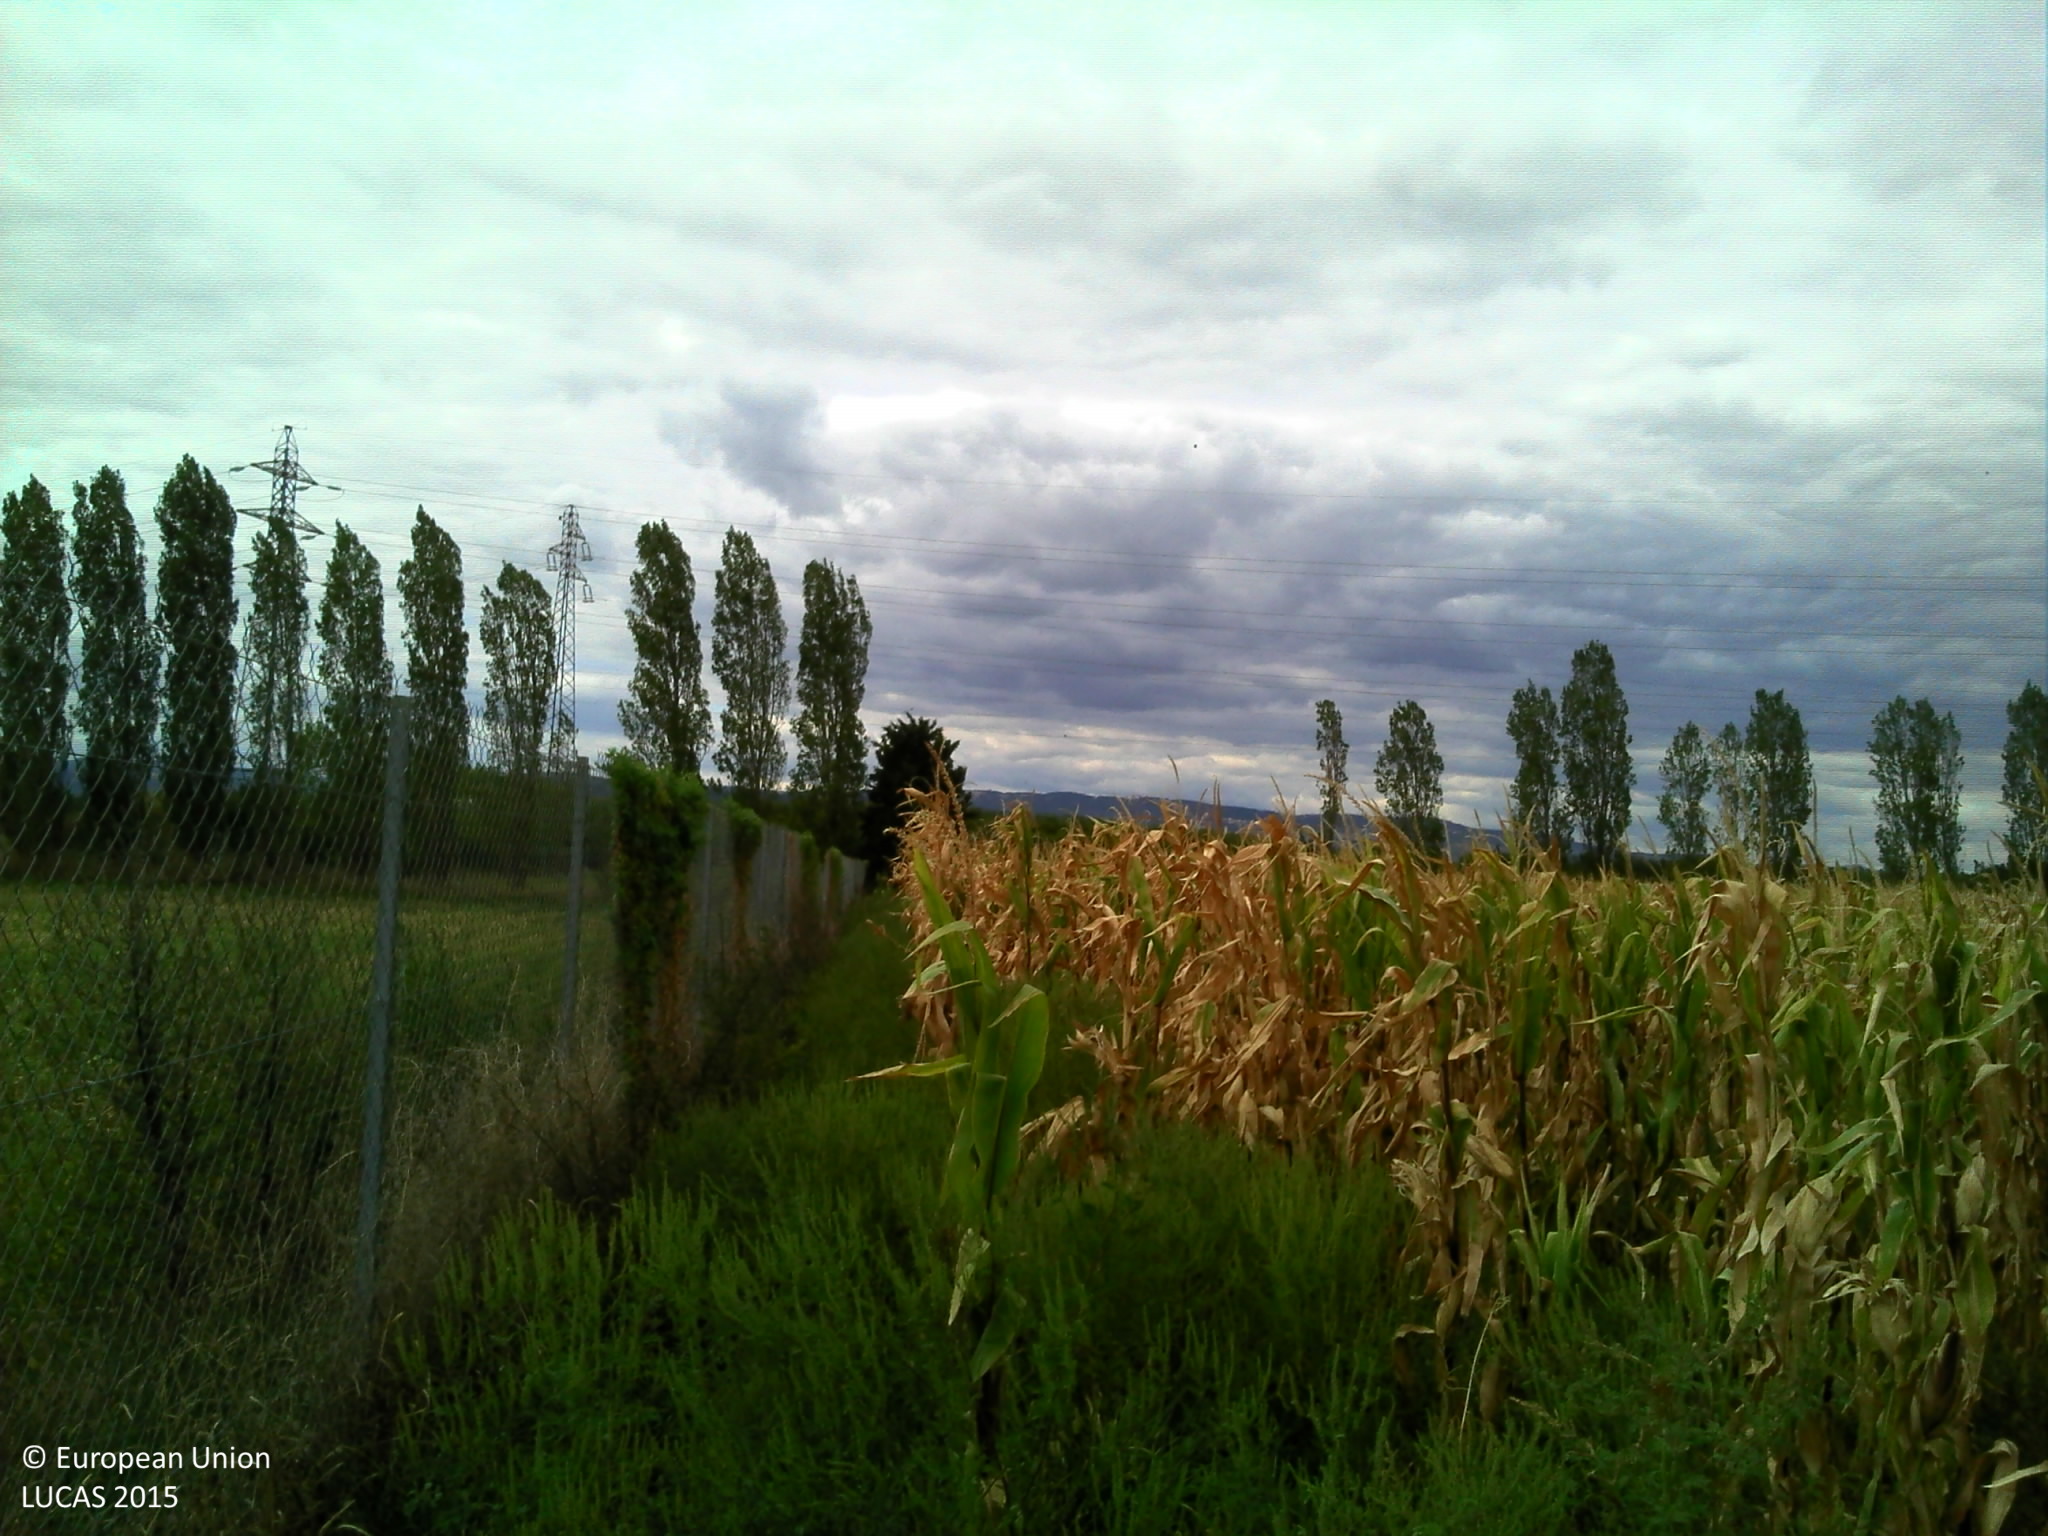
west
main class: Cropland
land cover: Maize
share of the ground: > 75 %
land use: Agriculture (excluding fallow land and kitchen gardens)
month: September
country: FR
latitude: 44.9130
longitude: 4.9265
